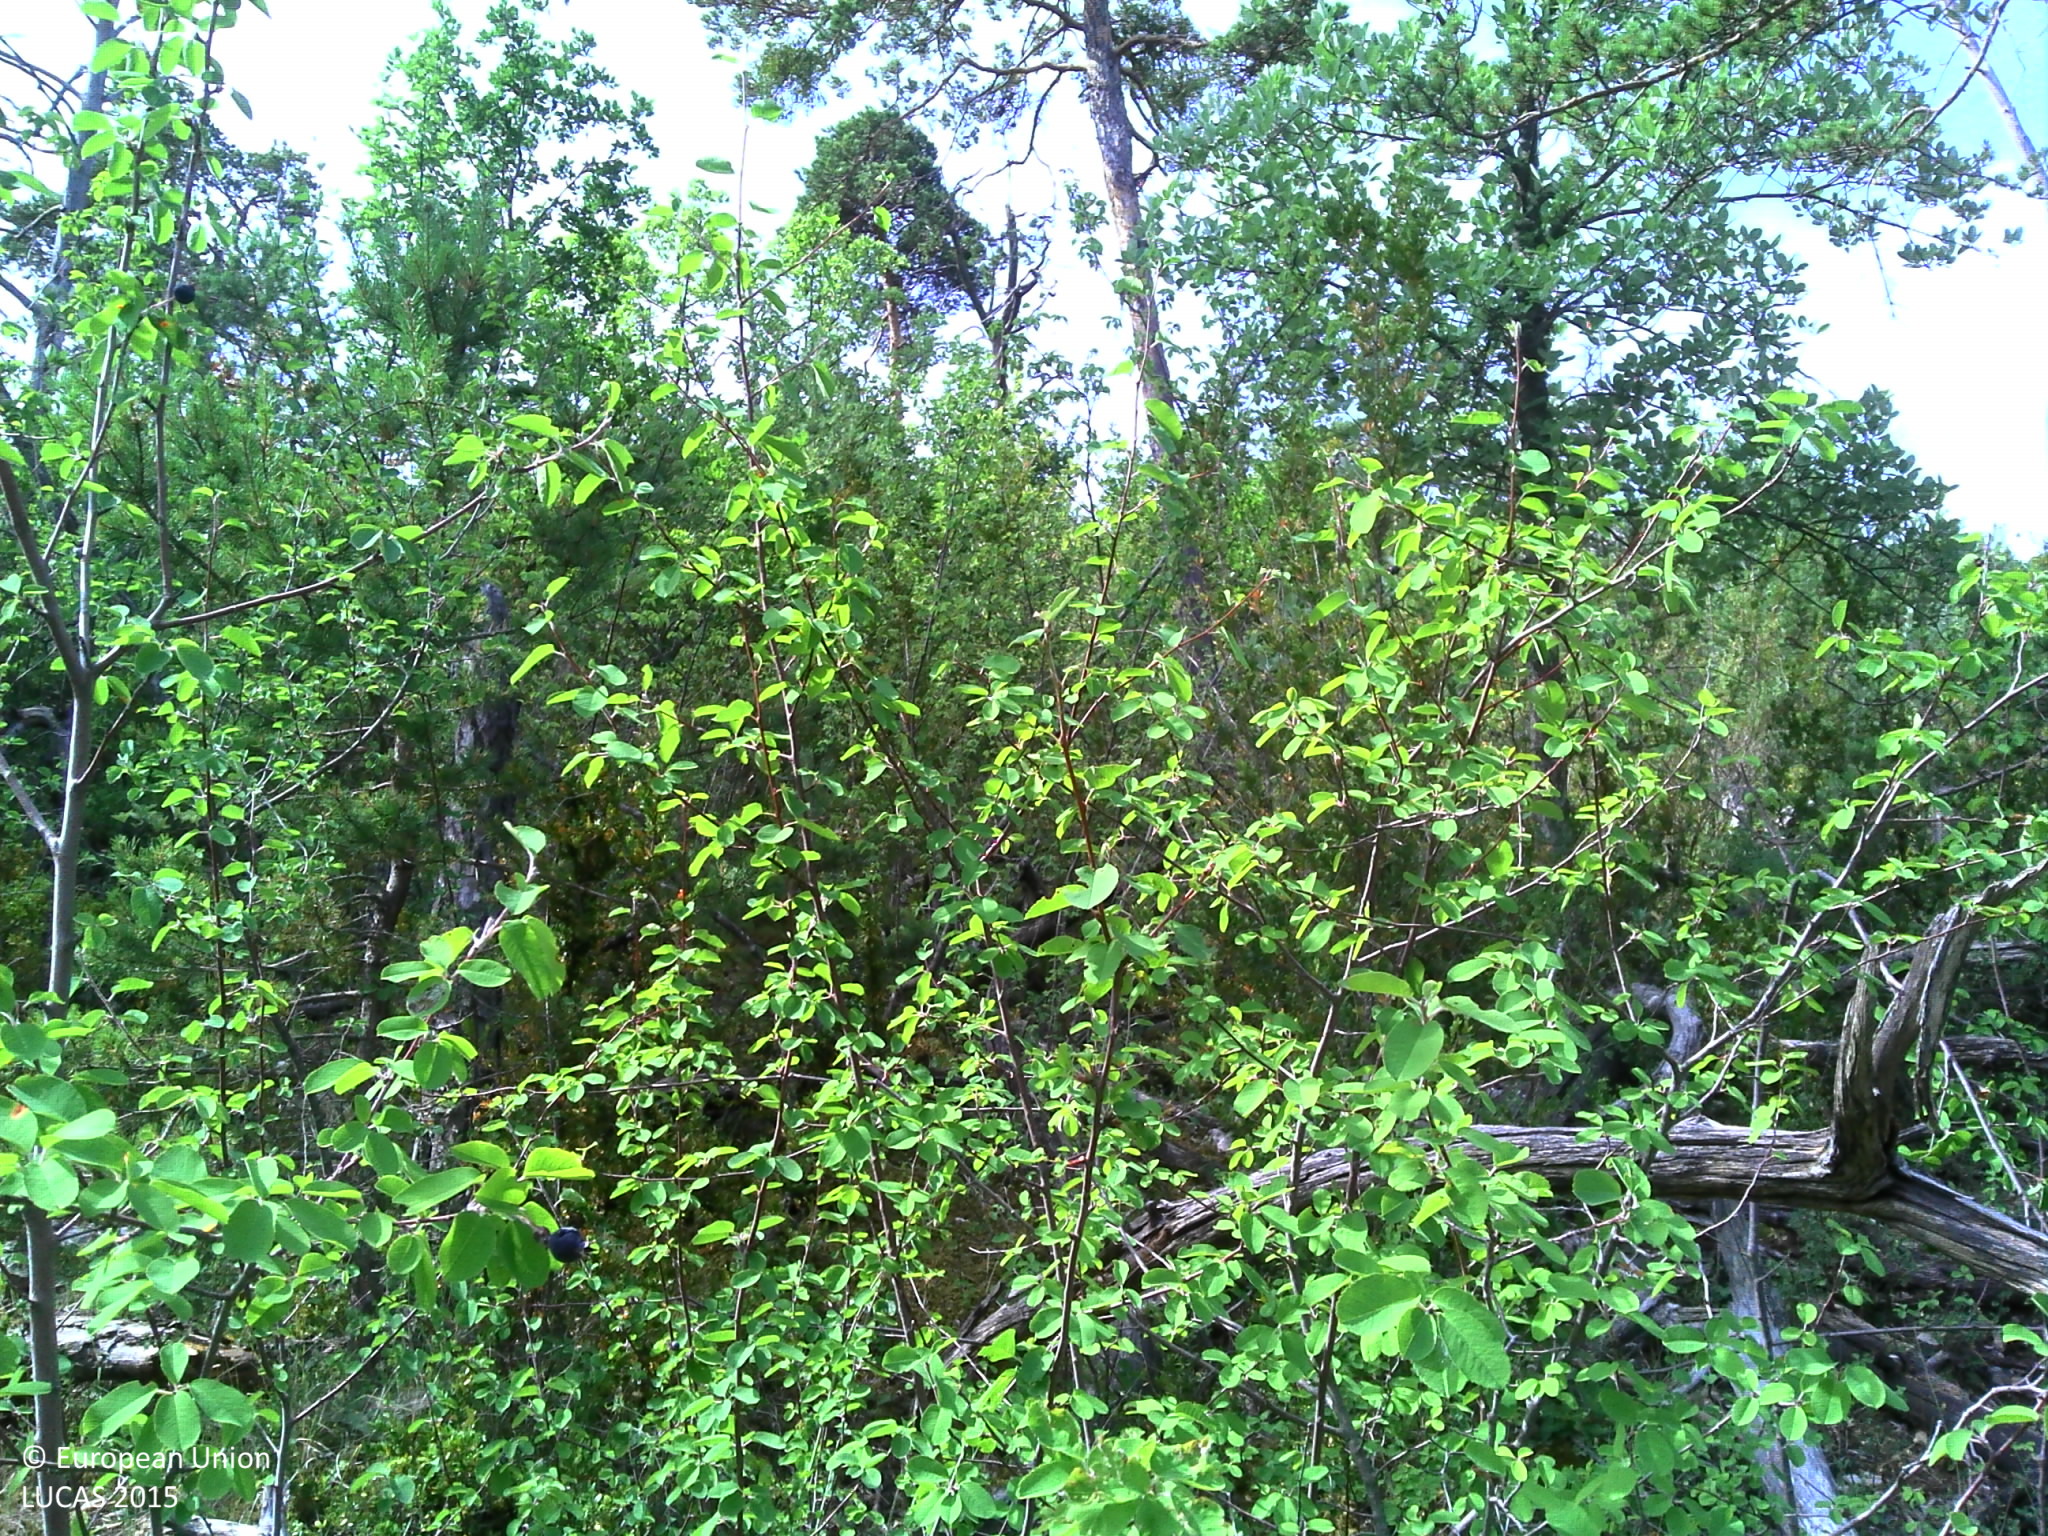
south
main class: Woodland
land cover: Pine dominated mixed woodland
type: coniferous forest of the mediterranean region
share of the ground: 50 - 75 %
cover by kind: coniferous forest trees 40 %, broadleaved forest trees 20 %, herbaceous plants 20 %, shrubs 10 %, lichens and mosses 10 %
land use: Forestry
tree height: > 5 m
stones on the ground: 25 - 50 %
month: July
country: FR
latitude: 43.7977
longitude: 6.3168
